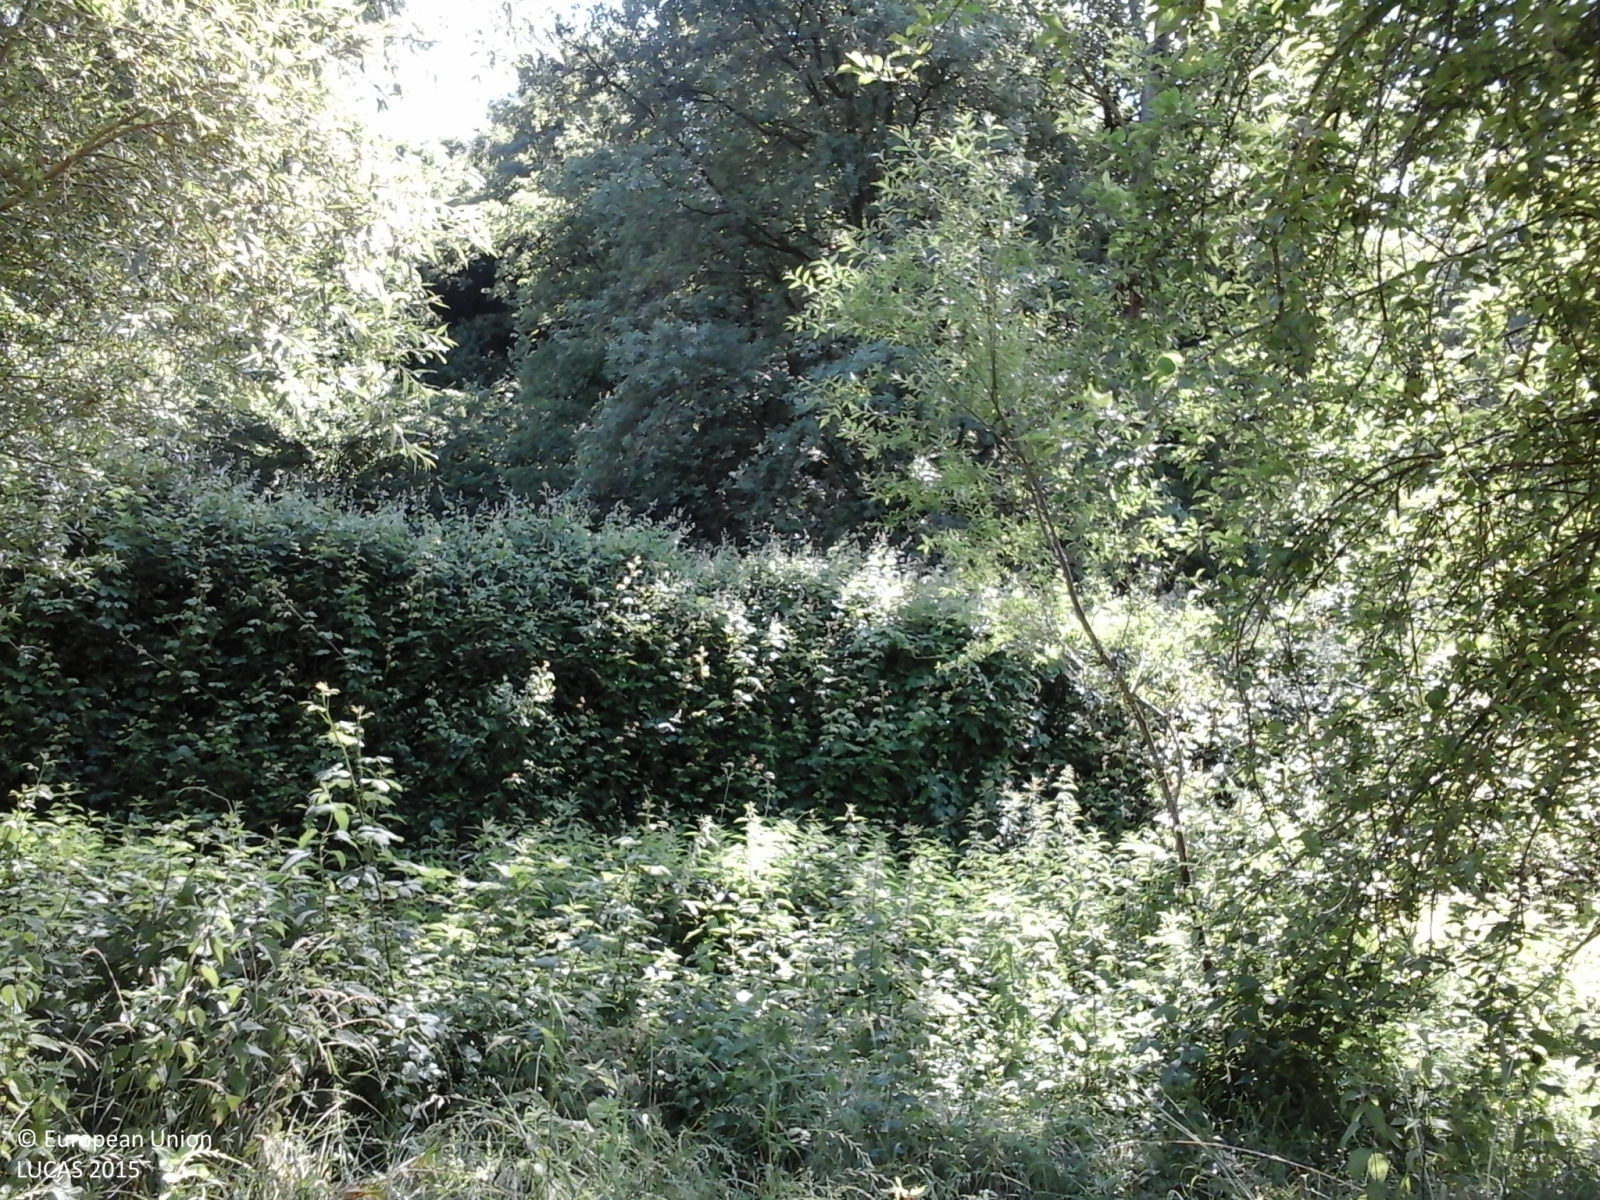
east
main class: Grassland
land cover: Grassland with sparse tree/shrub cover
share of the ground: 50 - 75 %
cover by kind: herbaceous plants 90 %, broadleaved forest trees 5 %, shrubs 5 %
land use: Agriculture (excluding fallow land and kitchen gardens)
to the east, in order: Grassland with sparse tree/shrub cover; Shrubland without tree cover; Ditches and canals; Shrubland without tree cover; Tracks; Fences; Shrubland without tree cover; Single bushes/trees; Grass margins; Tracks; Grass margins; Grassland with sparse tree/shrub cover; Cherry fruit; Olive groves; Fences; Olive groves; Artificial constructions; Fences; Other fruit trees and berries; Broadleaved woodland; Other fruit trees and berries; Grassland without tree/shrub cover
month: May
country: IT
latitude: 41.6933
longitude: 13.3877
